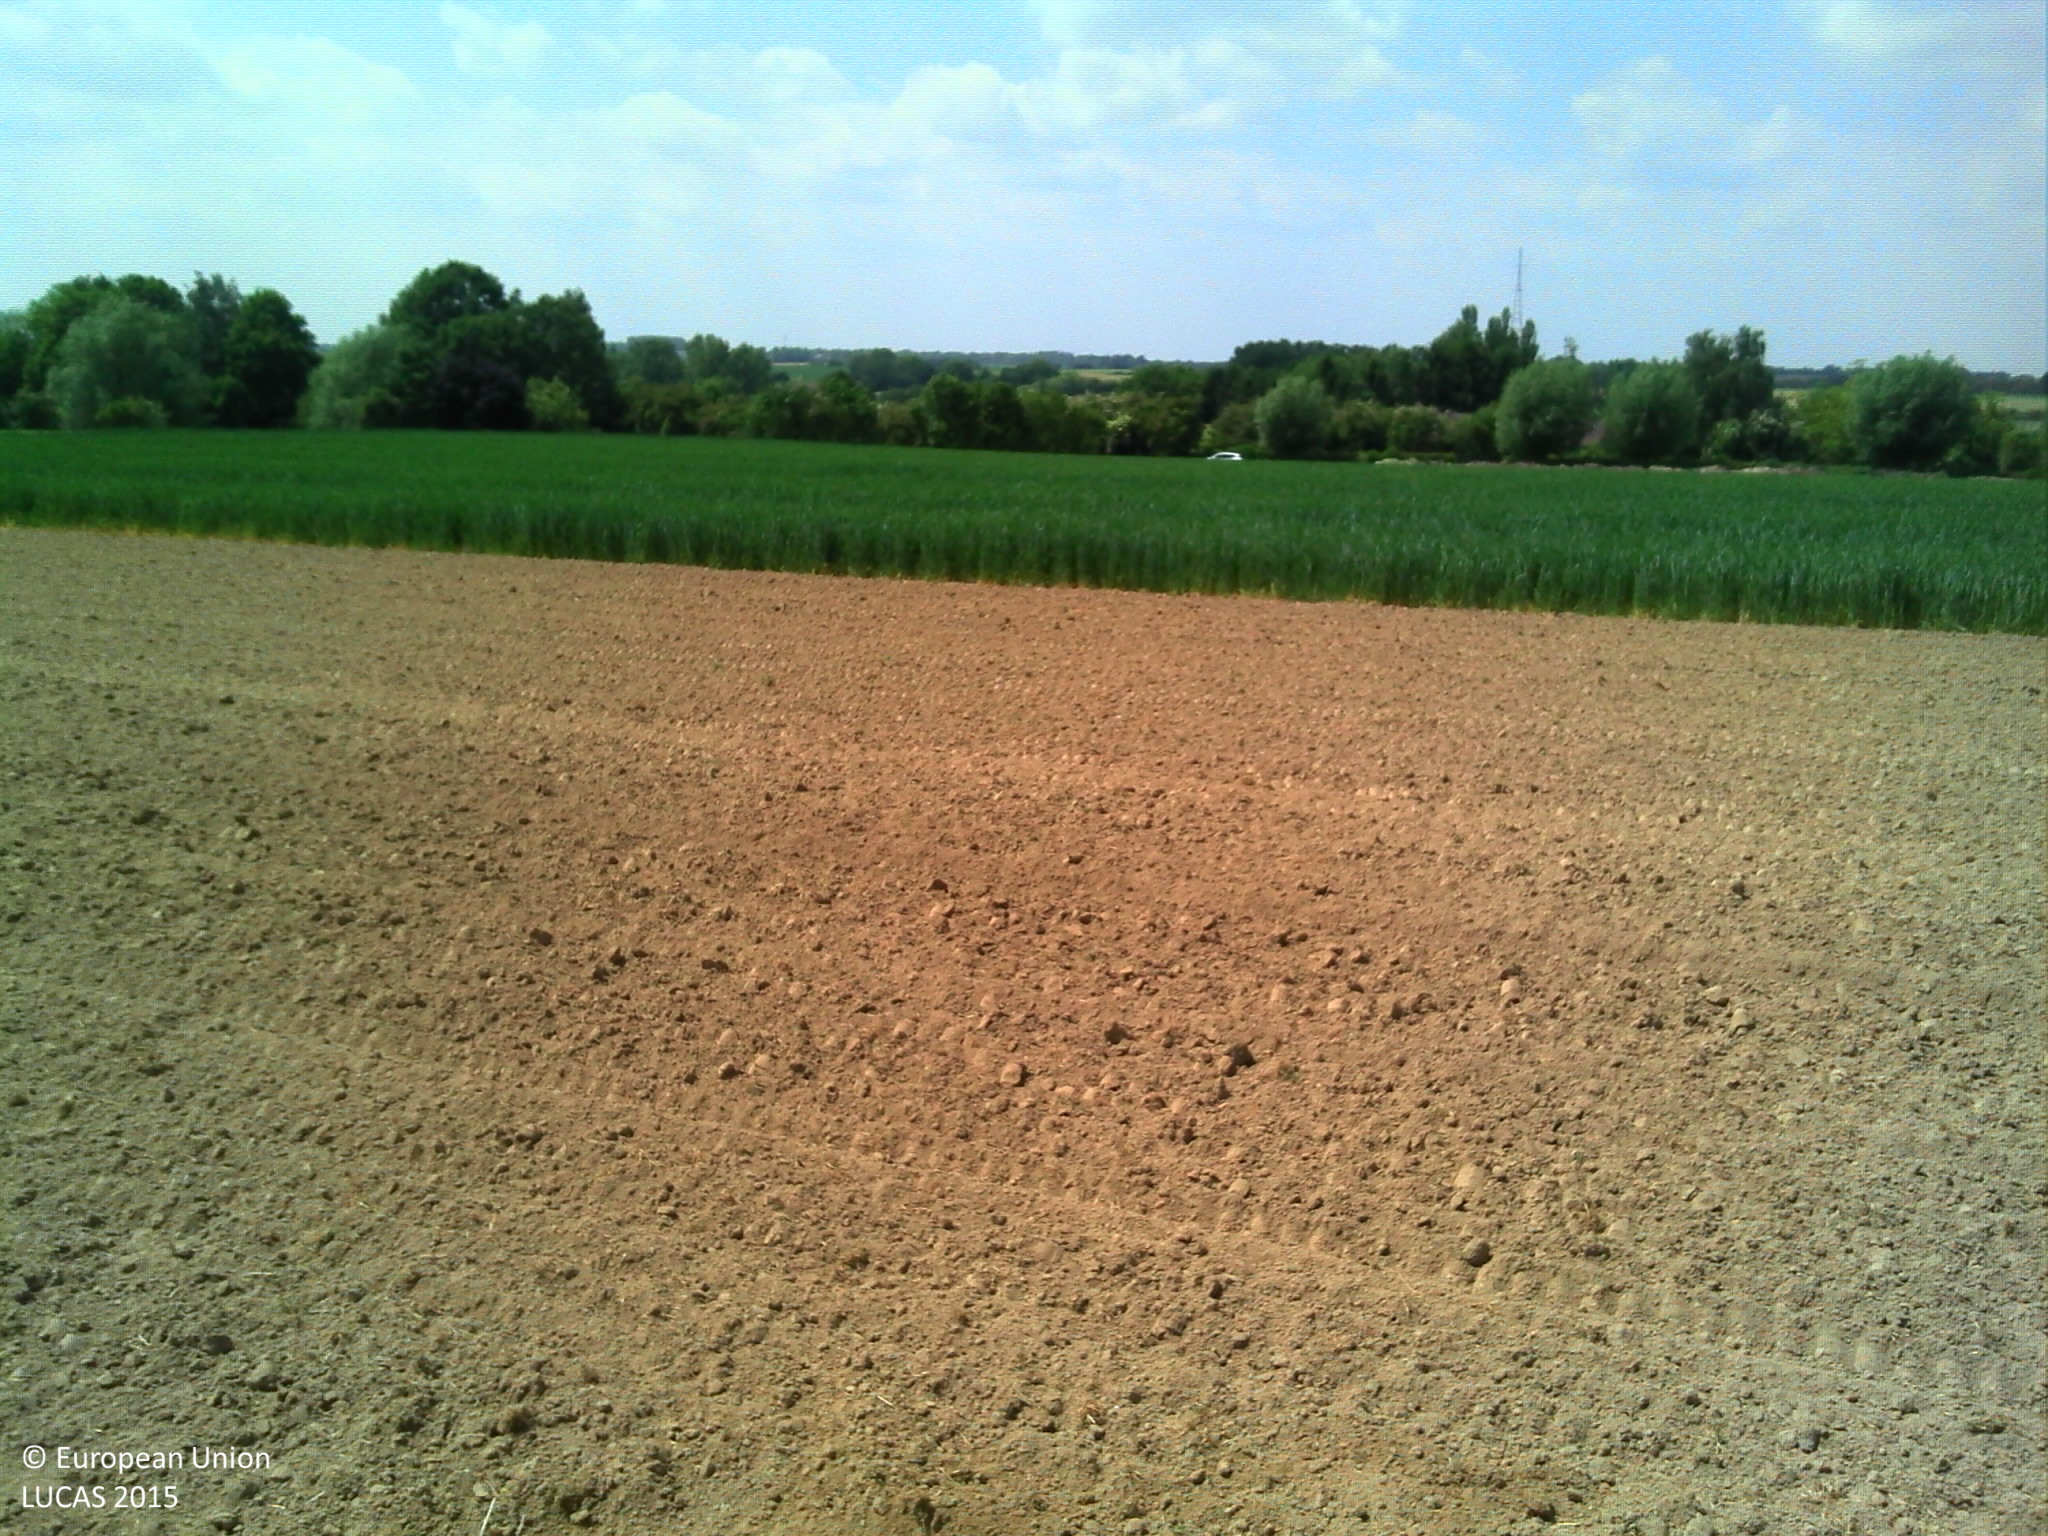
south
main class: Cropland
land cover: Maize
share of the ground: < 10 %
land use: Agriculture (excluding fallow land and kitchen gardens)
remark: Tilled/Sowed
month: May
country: BE
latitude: 50.5976
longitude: 4.6135
